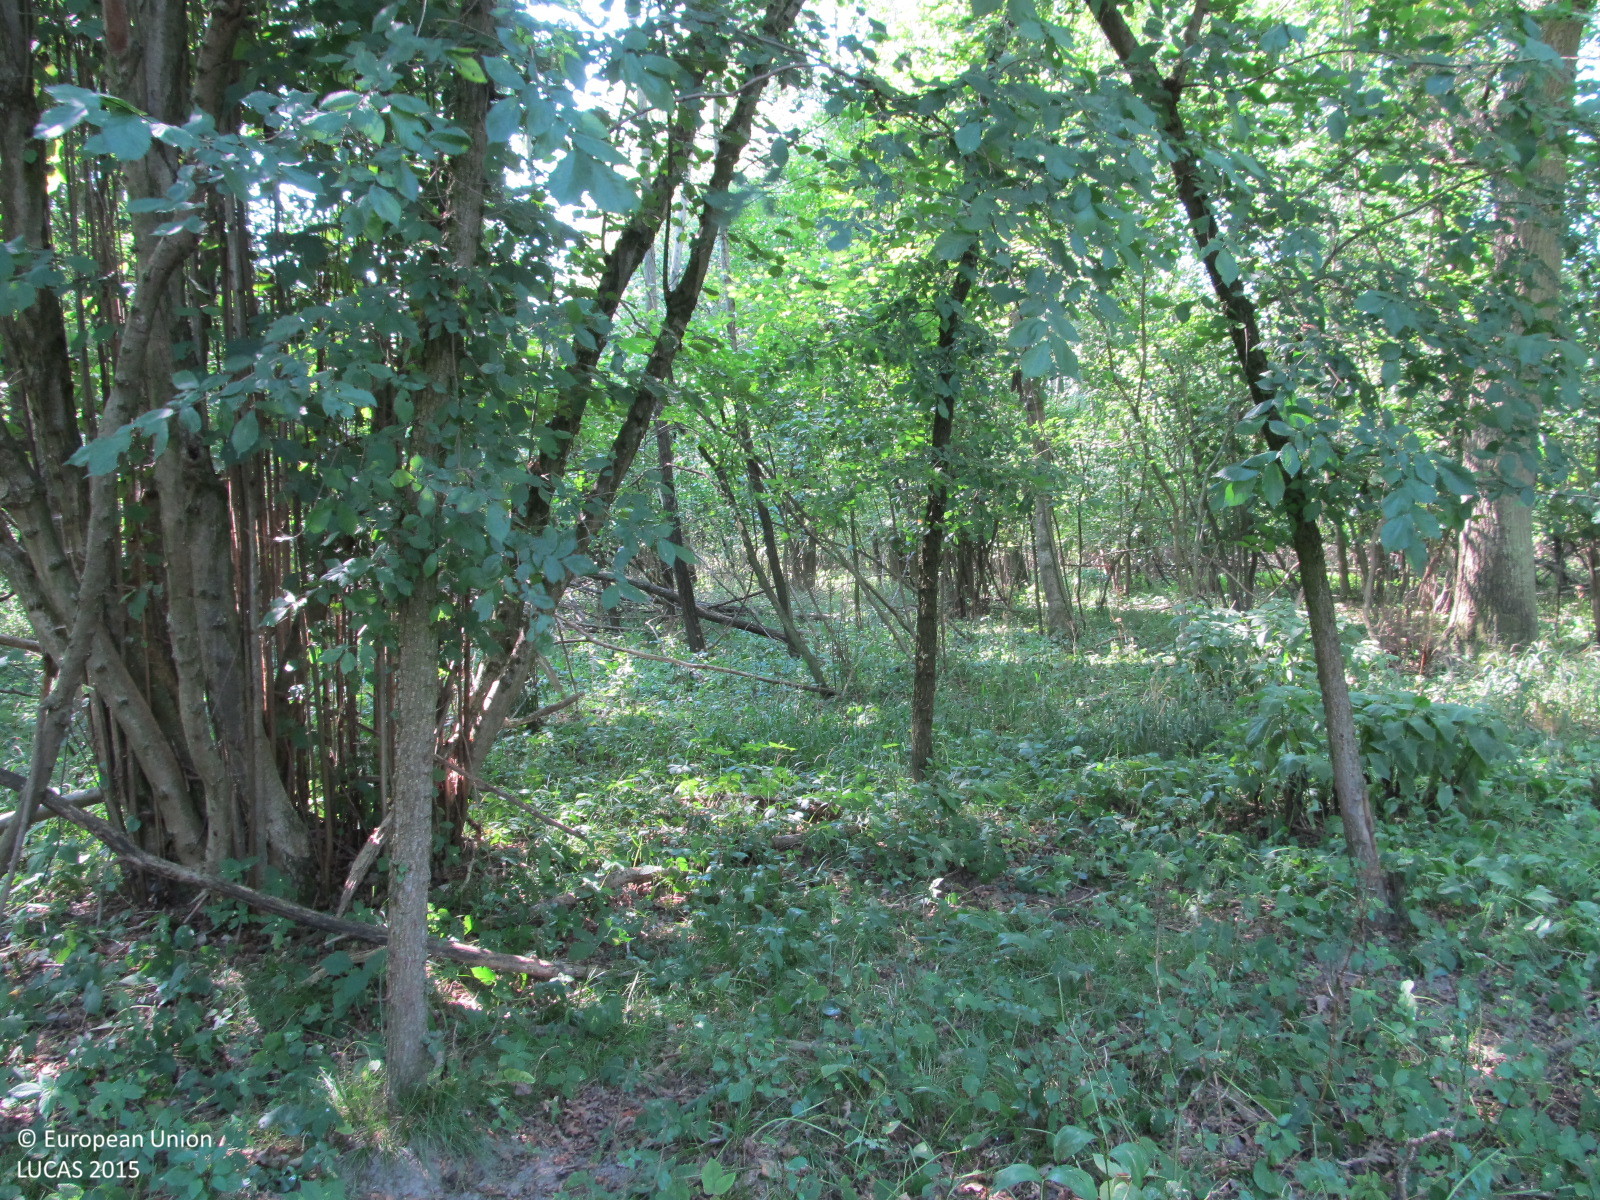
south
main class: Woodland
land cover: Broadleaved woodland
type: floodplain forest
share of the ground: > 75 %
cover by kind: broadleaved forest trees 75 %, shrubs 20 %, herbaceous plants 5 %
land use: Agriculture (excluding fallow land and kitchen gardens)
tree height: > 5 m
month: August
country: AT
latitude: 48.3556
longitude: 15.8741
